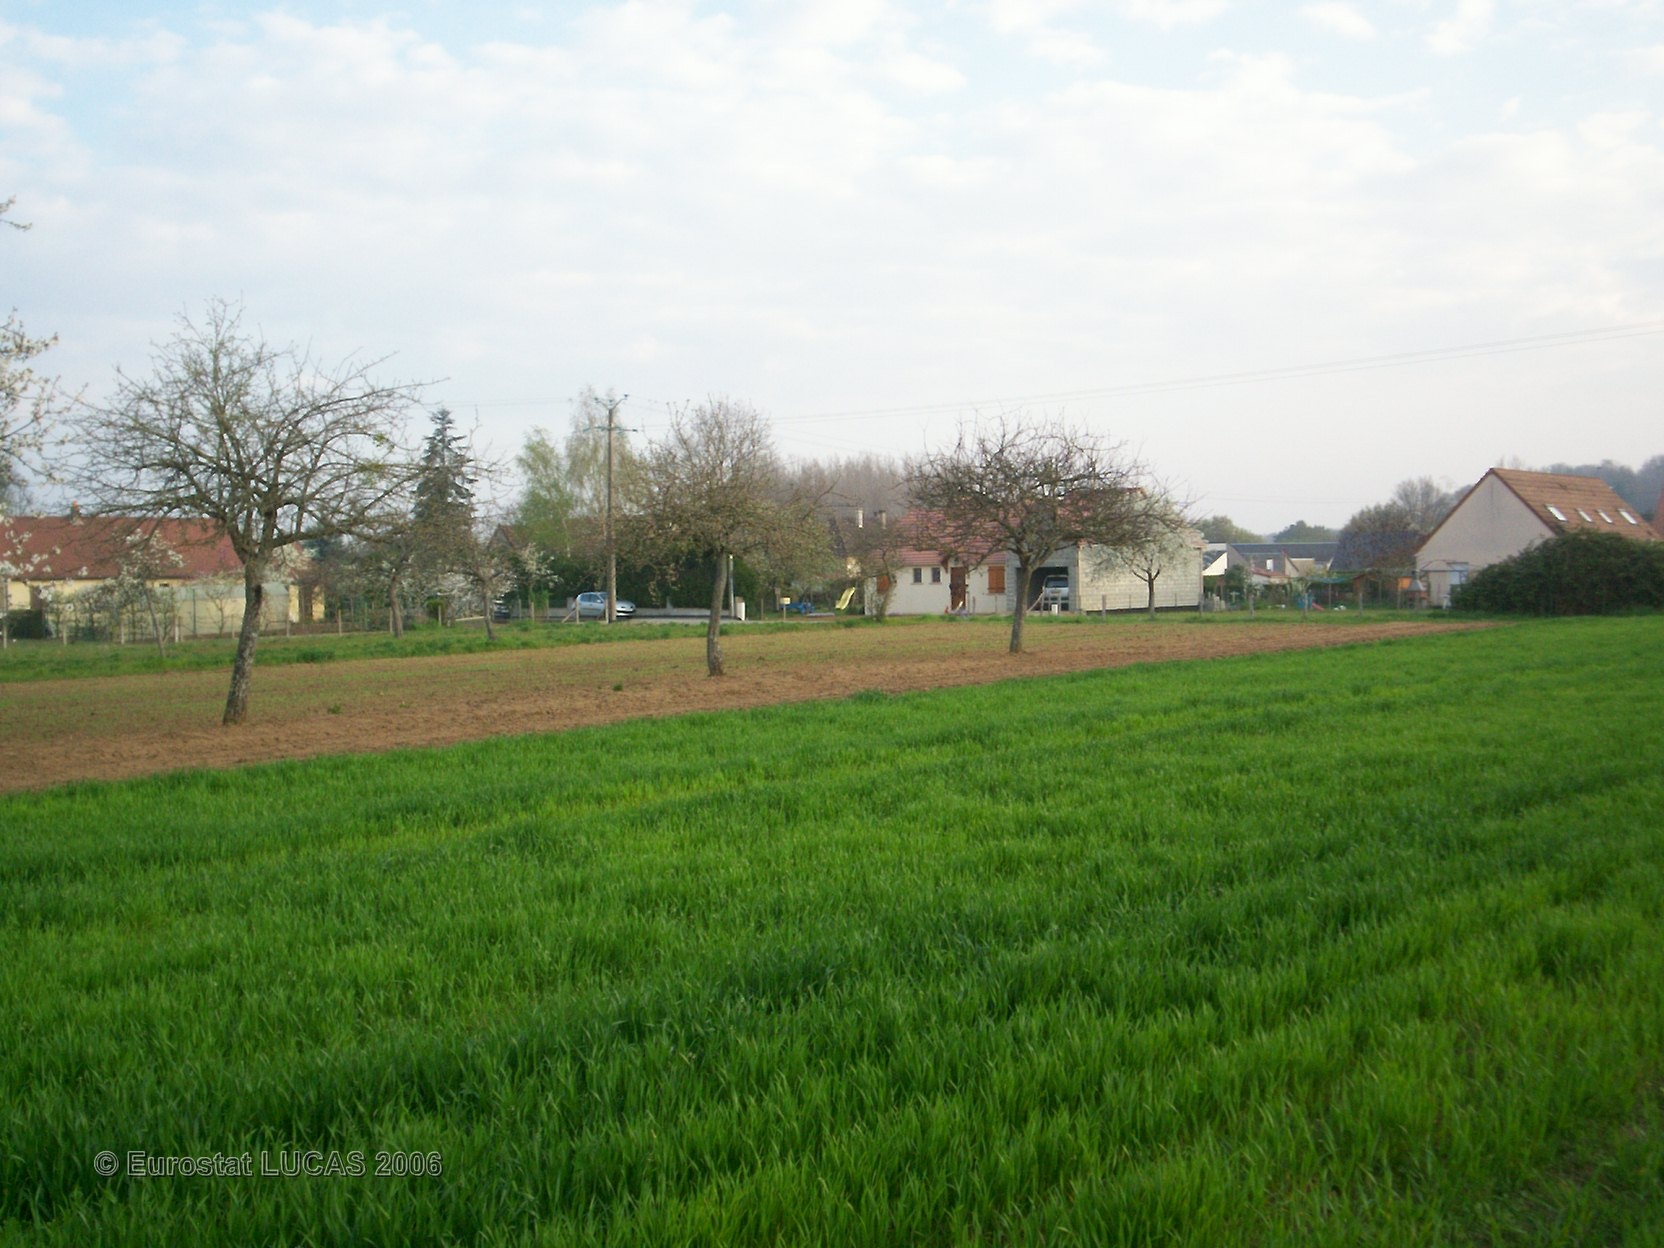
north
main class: Cropland
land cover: Common wheat
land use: Agriculture (excluding fallow land and kitchen gardens)
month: April
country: FR
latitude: 48.1449
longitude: 0.3653
